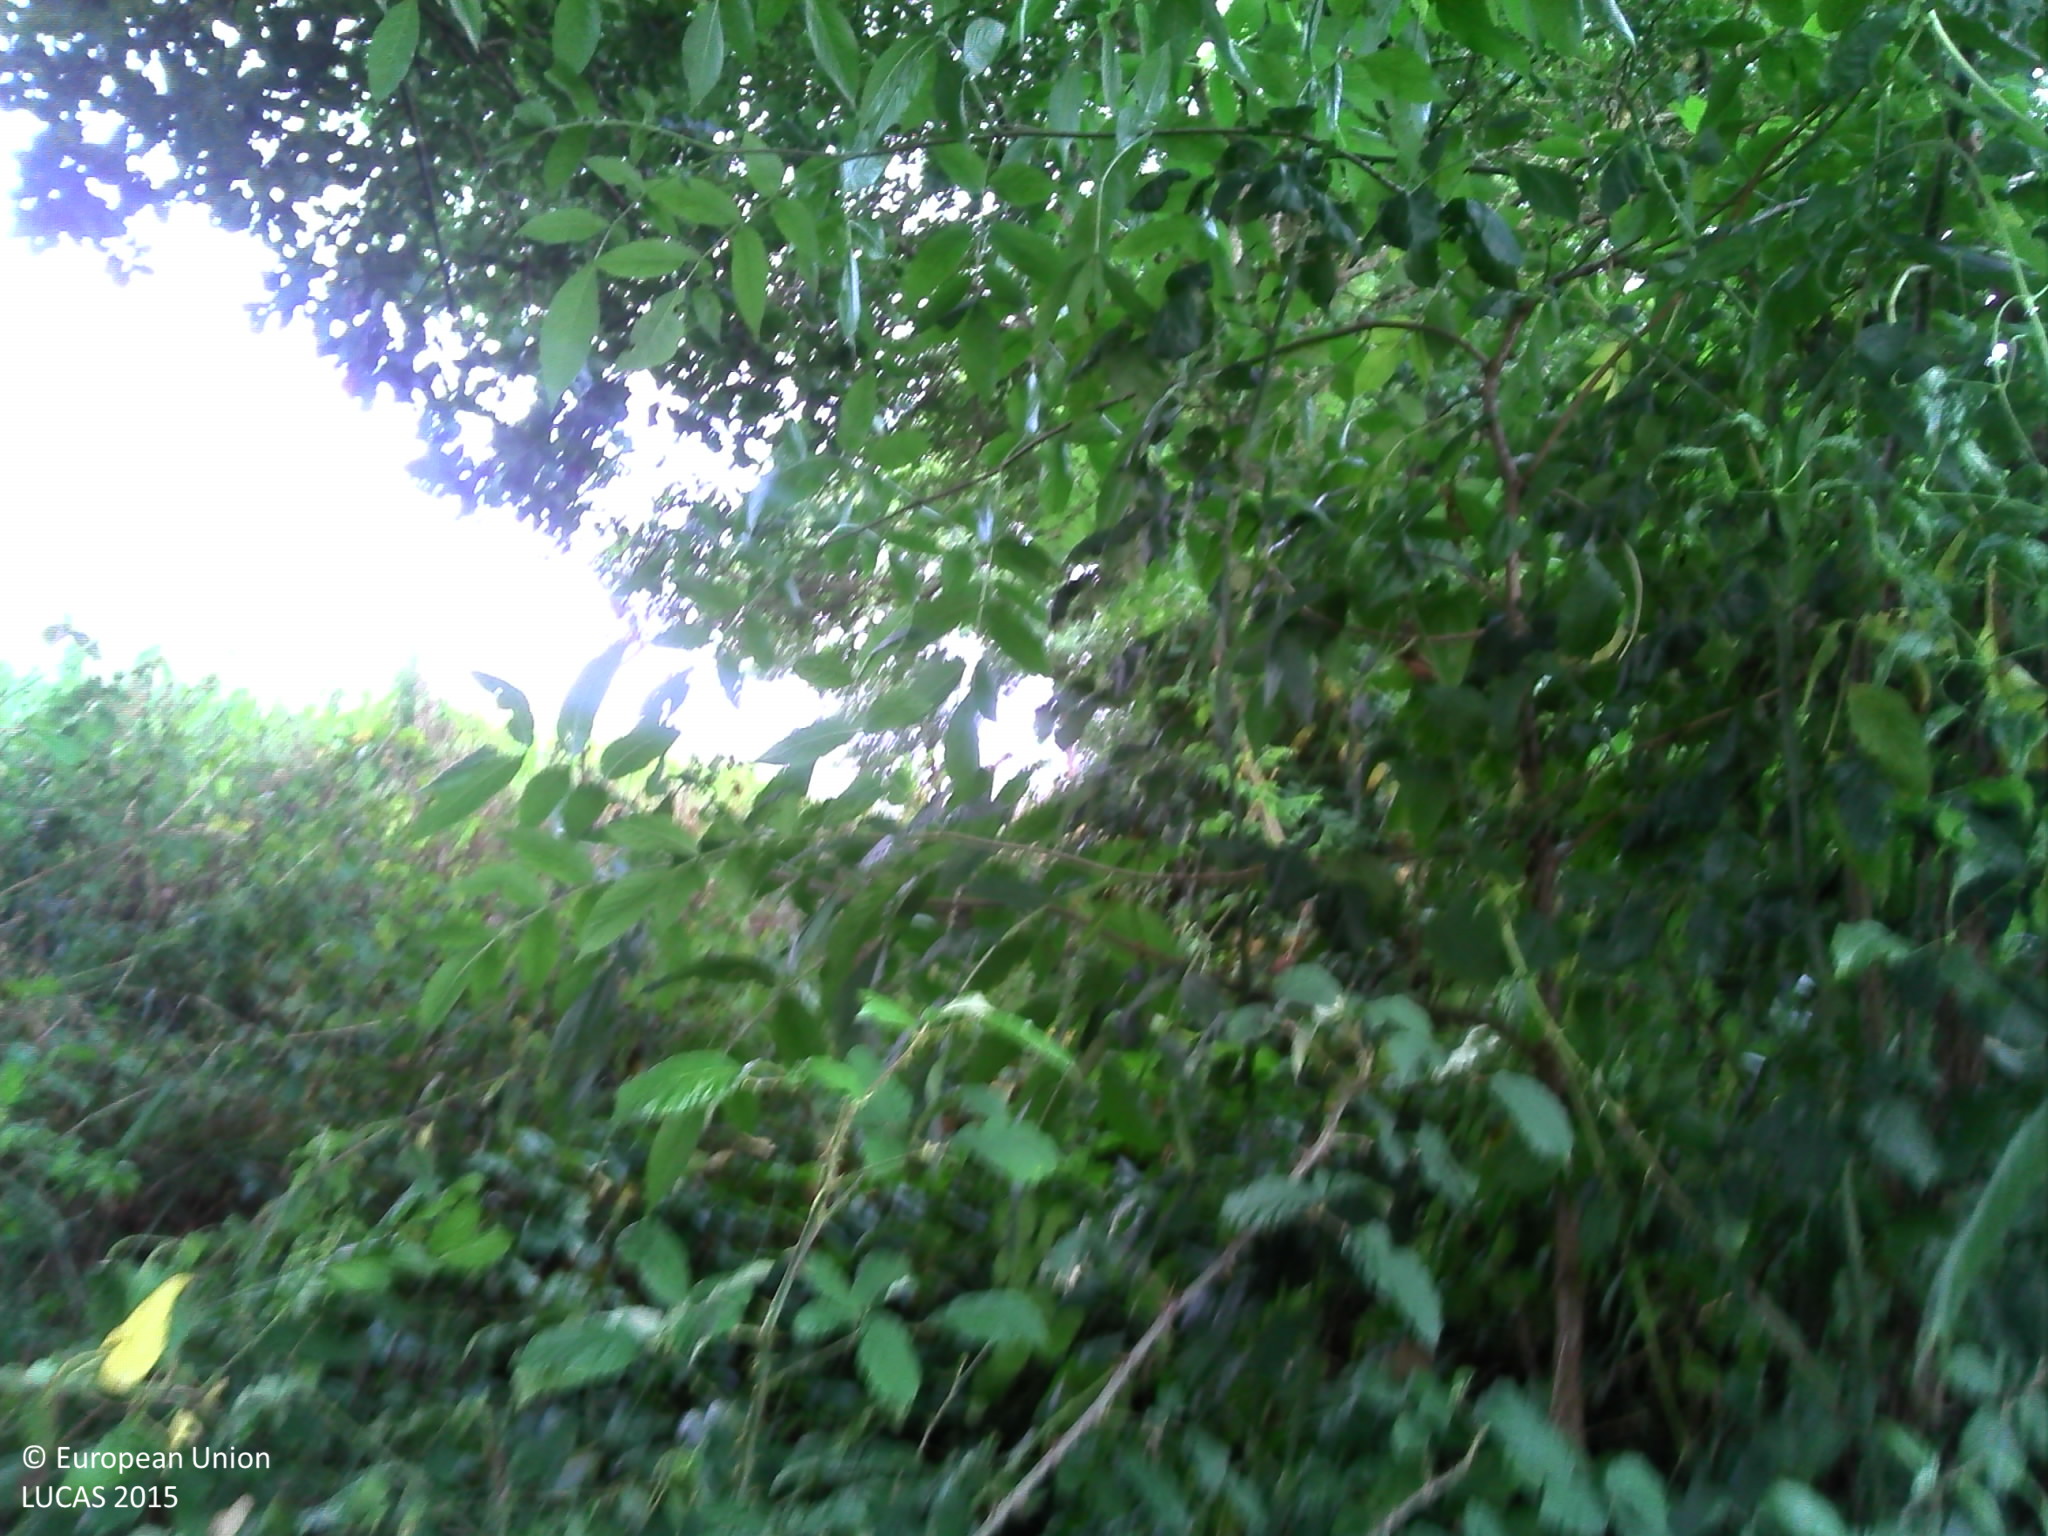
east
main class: Woodland
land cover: Broadleaved woodland
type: mesophytic deciduous forest
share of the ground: > 75 %
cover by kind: broadleaved forest trees 65 %, shrubs 30 %, herbaceous plants 5 %
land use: Semi-natural and natural areas not in use
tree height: > 5 m
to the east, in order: Broadleaved woodland; Spontaneously vegetated surfaces; Maize; Single bushes/trees; Fences; Abandoned hedges; Grassland without tree/shrub cover; Fences; Broadleaved woodland; Spontaneously vegetated surfaces; Ditches and canals
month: August
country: FR
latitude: 43.3728
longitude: -1.0839
